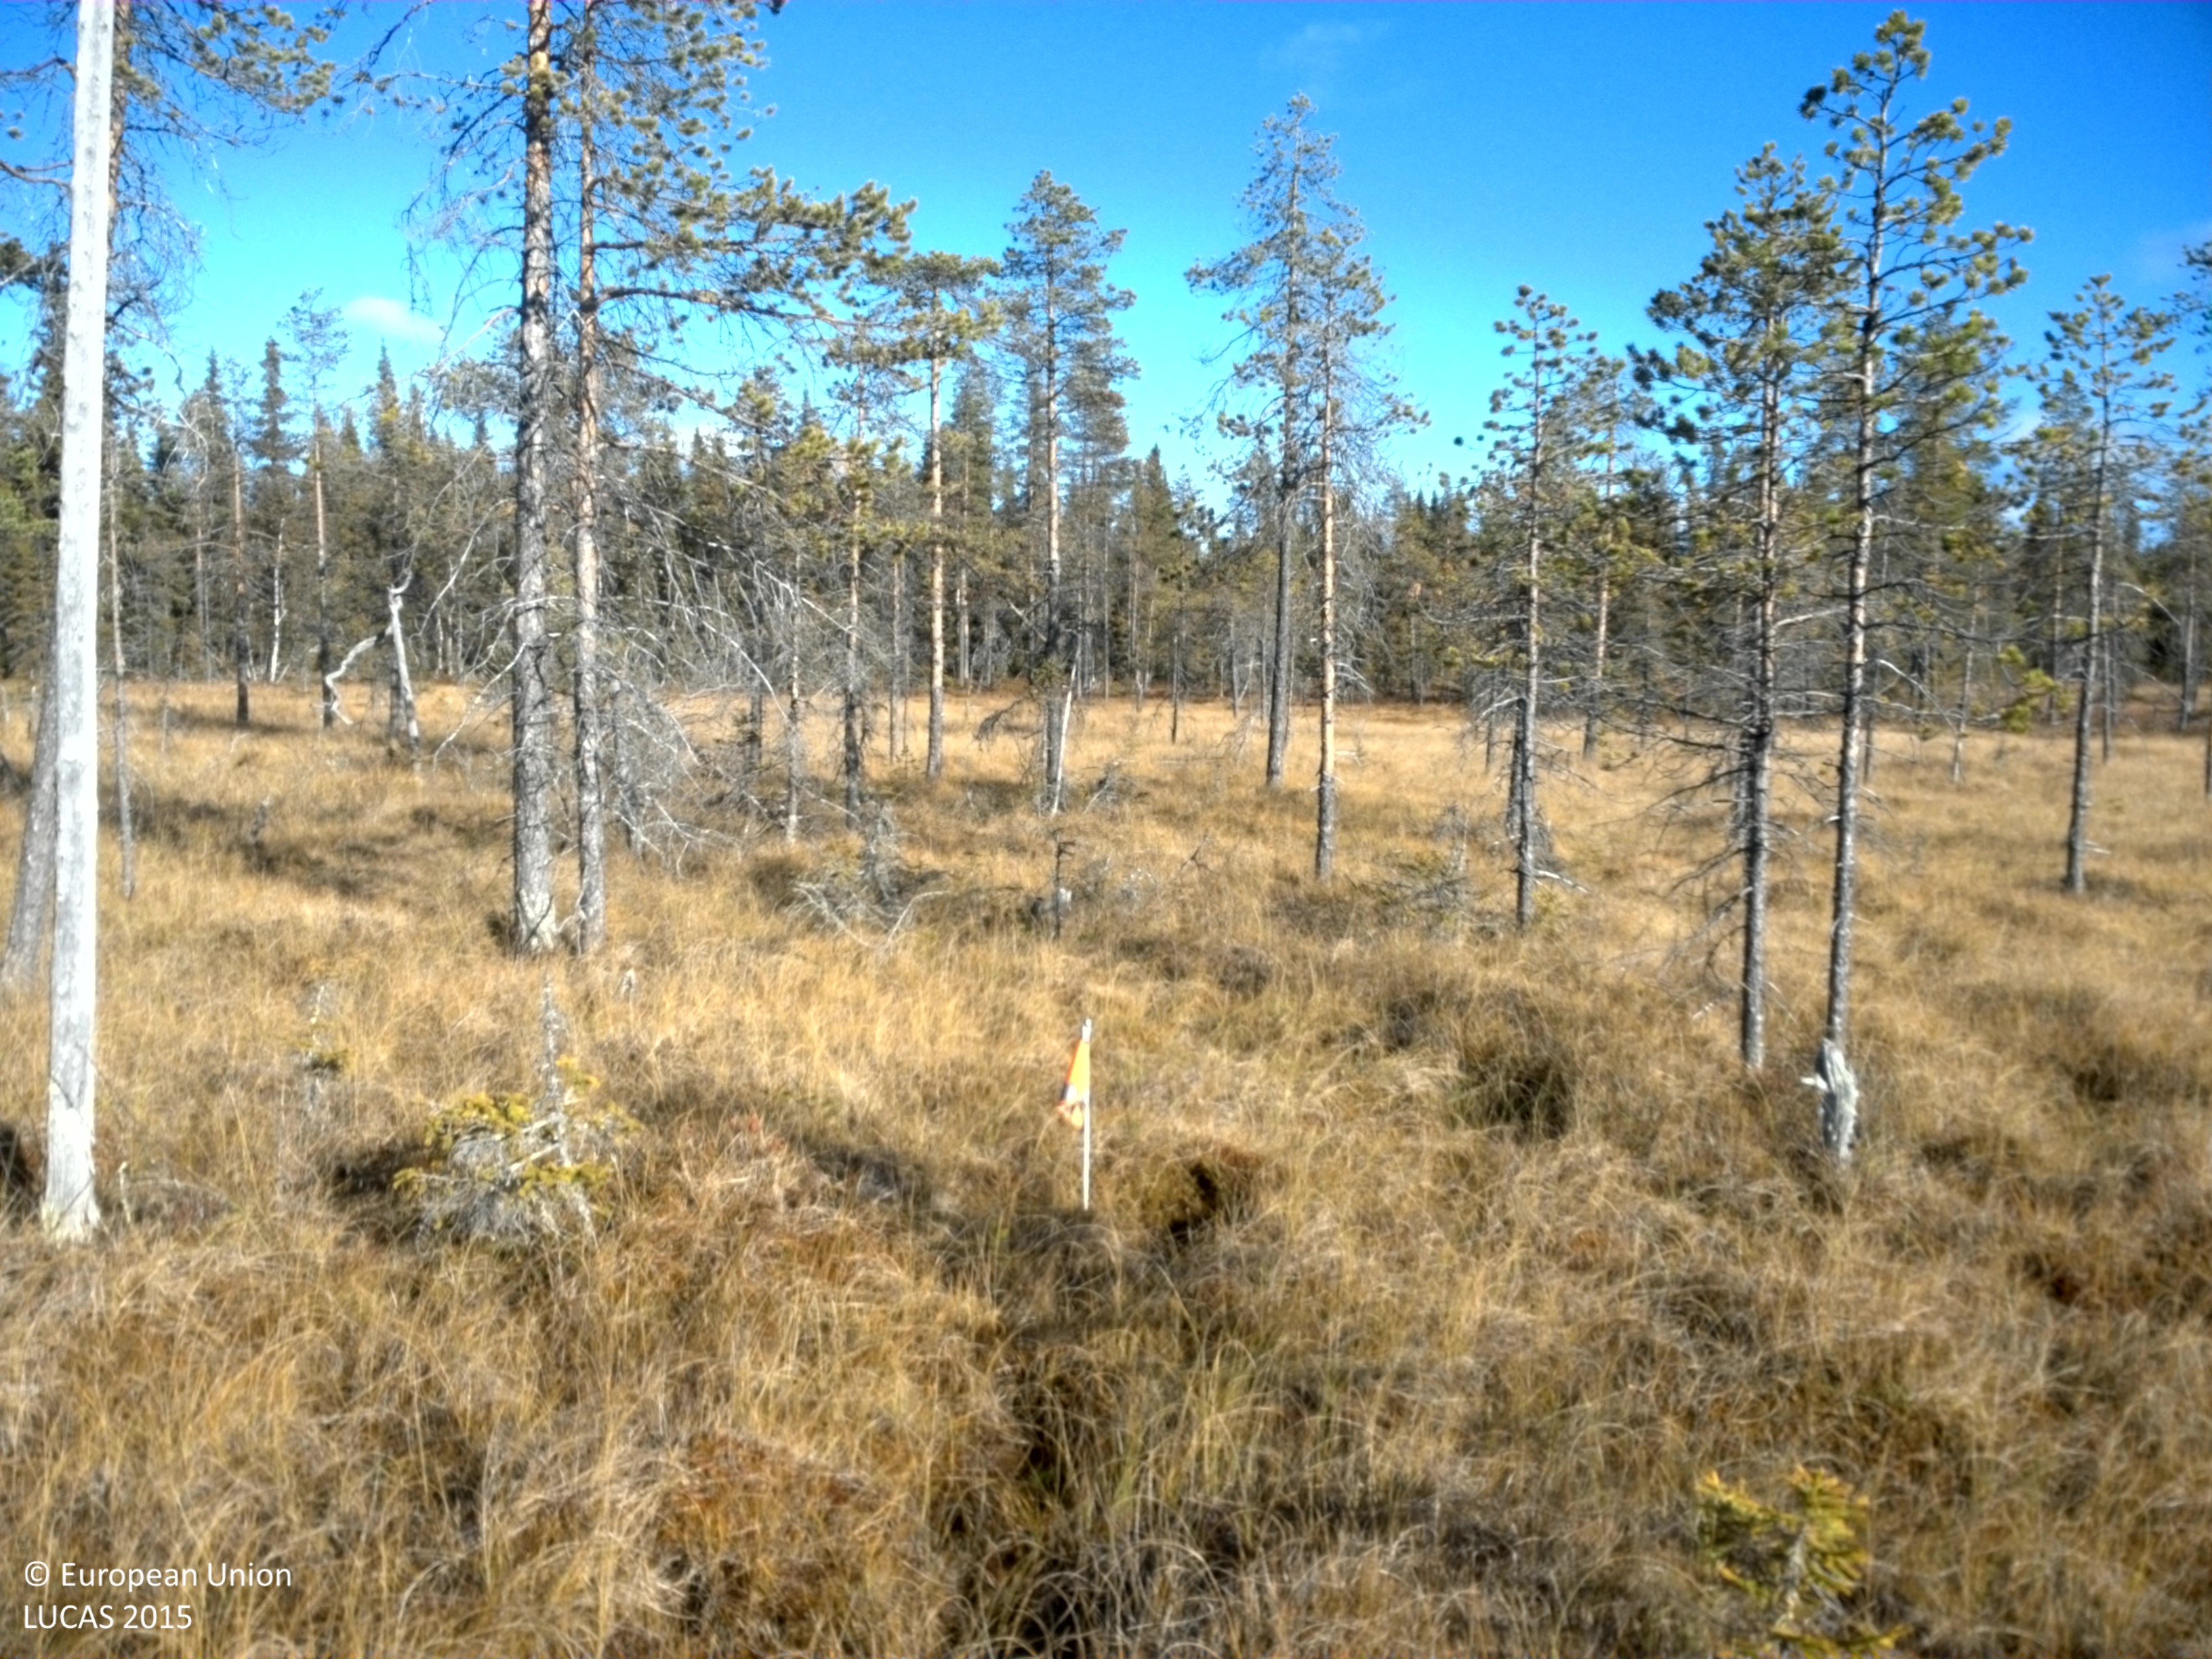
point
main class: Woodland
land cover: Pine dominated coniferous woodland
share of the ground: 10 - 25 %
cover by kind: herbaceous plants 70 %, coniferous forest trees 10 %, shrubs 10 %, lichens and mosses 10 %
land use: Semi-natural and natural areas not in use
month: October
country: SE
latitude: 64.7987
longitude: 17.5635
